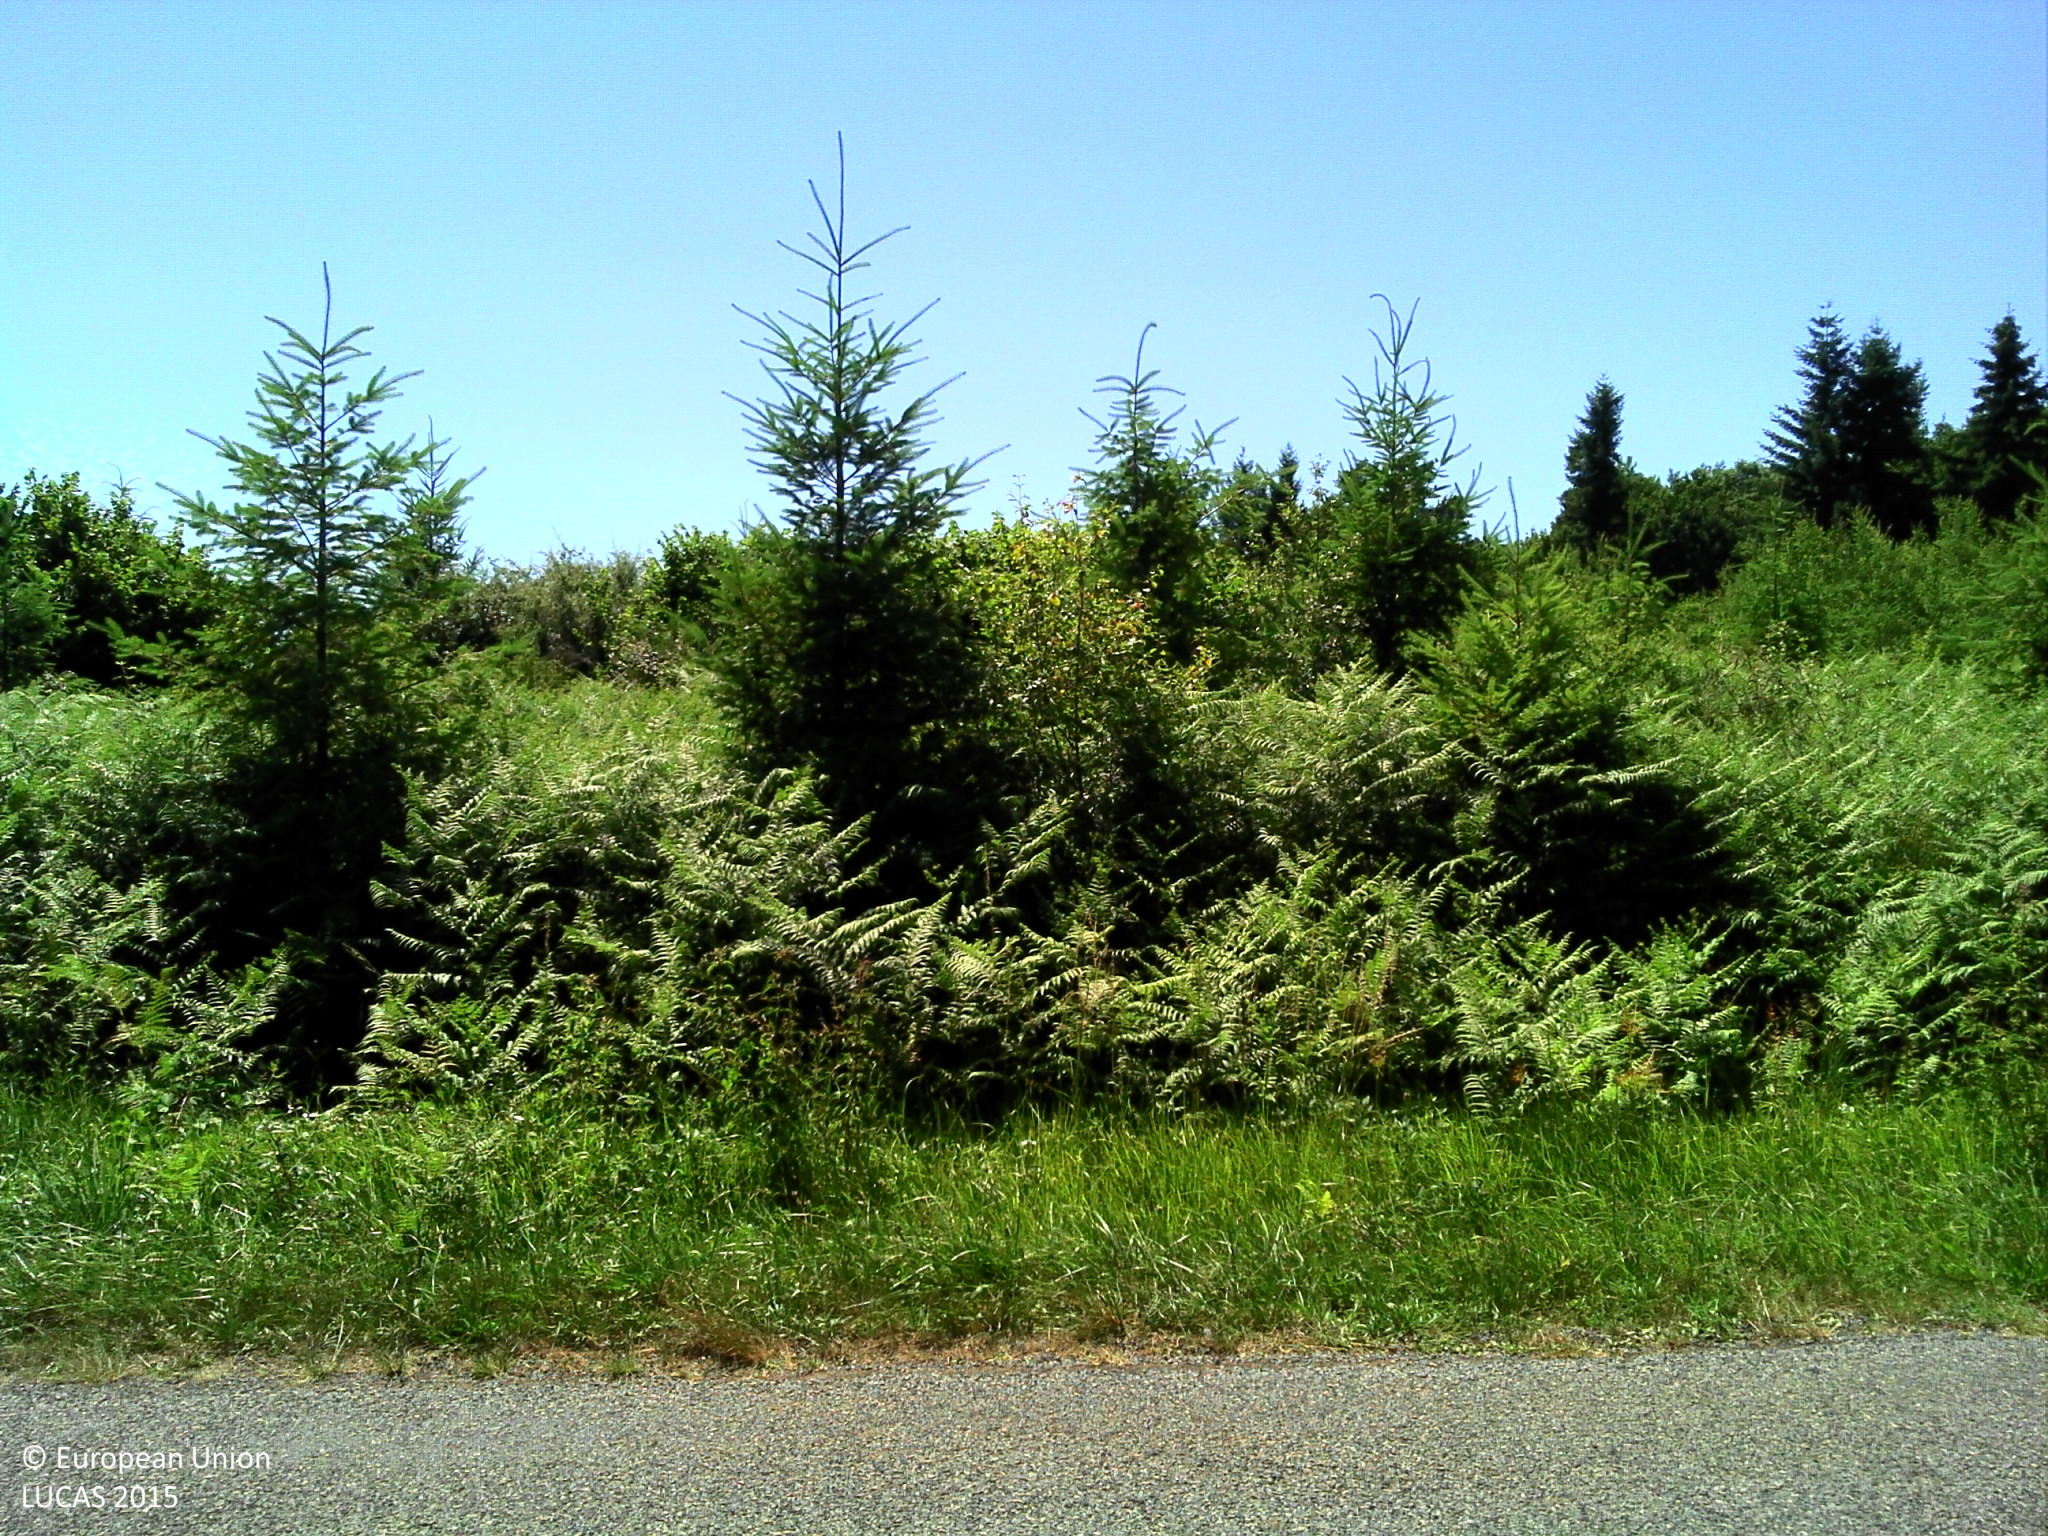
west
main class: Woodland
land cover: Broadleaved woodland
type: thermophilous deciduous forest
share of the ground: > 75 %
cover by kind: broadleaved forest trees 90 %, herbaceous plants 10 %
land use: Forestry
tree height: > 5 m
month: June
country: FR
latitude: 45.5798
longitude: 0.4643
